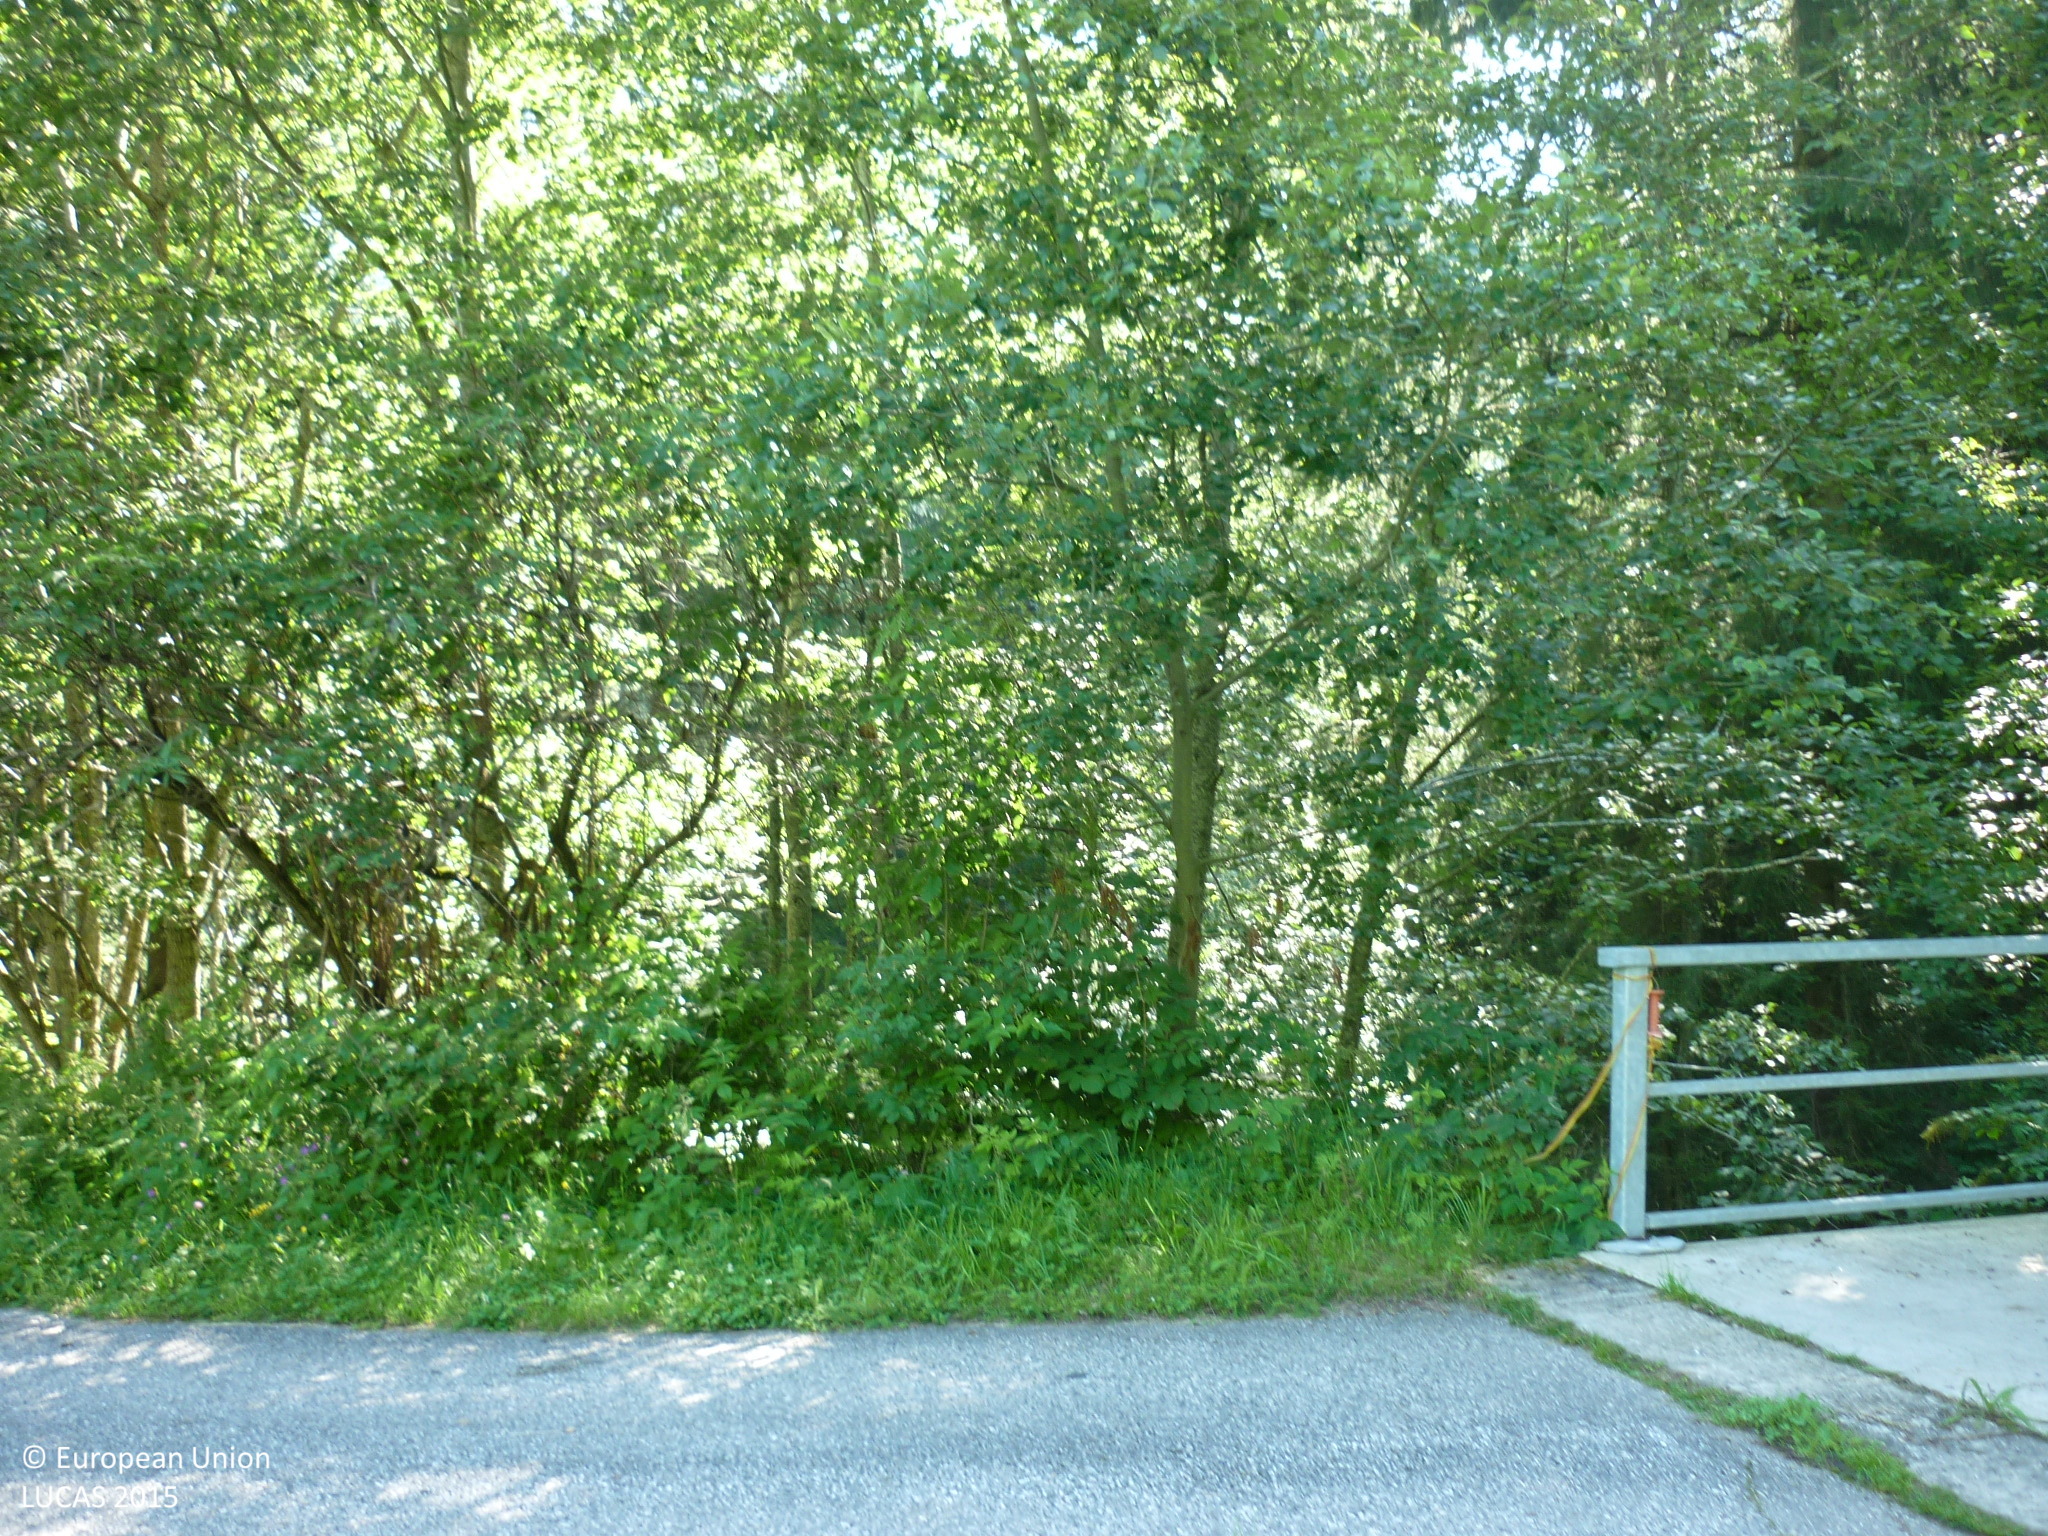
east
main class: Grassland
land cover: Grassland without tree/shrub cover
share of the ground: > 75 %
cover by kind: herbaceous plants 100 %
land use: Agriculture (excluding fallow land and kitchen gardens)
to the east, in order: Grassland without tree/shrub cover; Electric lines; Grassland without tree/shrub cover; Paved roads, cycling and walking lanes; Grass margins; Broadleaved woodland; Spruce dominated mixed woodland; Rivers and streams; Spruce dominated mixed woodland; Spruce dominated coniferous woodland; Broadleaved woodland; Dry stone walls; Paved roads, cycling and walking lanes; Grass margins; Spruce dominated mixed woodland; Grass margins; Paved roads, cycling and walking lanes; Spontaneously vegetated surfaces; Abandoned hedges; Inland fresh running water; Abandoned hedges; Grass margins; Paved roads, cycling and walking lanes; Grass margins; Fences; Spruce dominated mixed woodland; Fences; Spruce dominated mixed woodland; Fences; Spruce dominated coniferous woodland
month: August
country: AT
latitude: 46.9042
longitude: 13.5815
